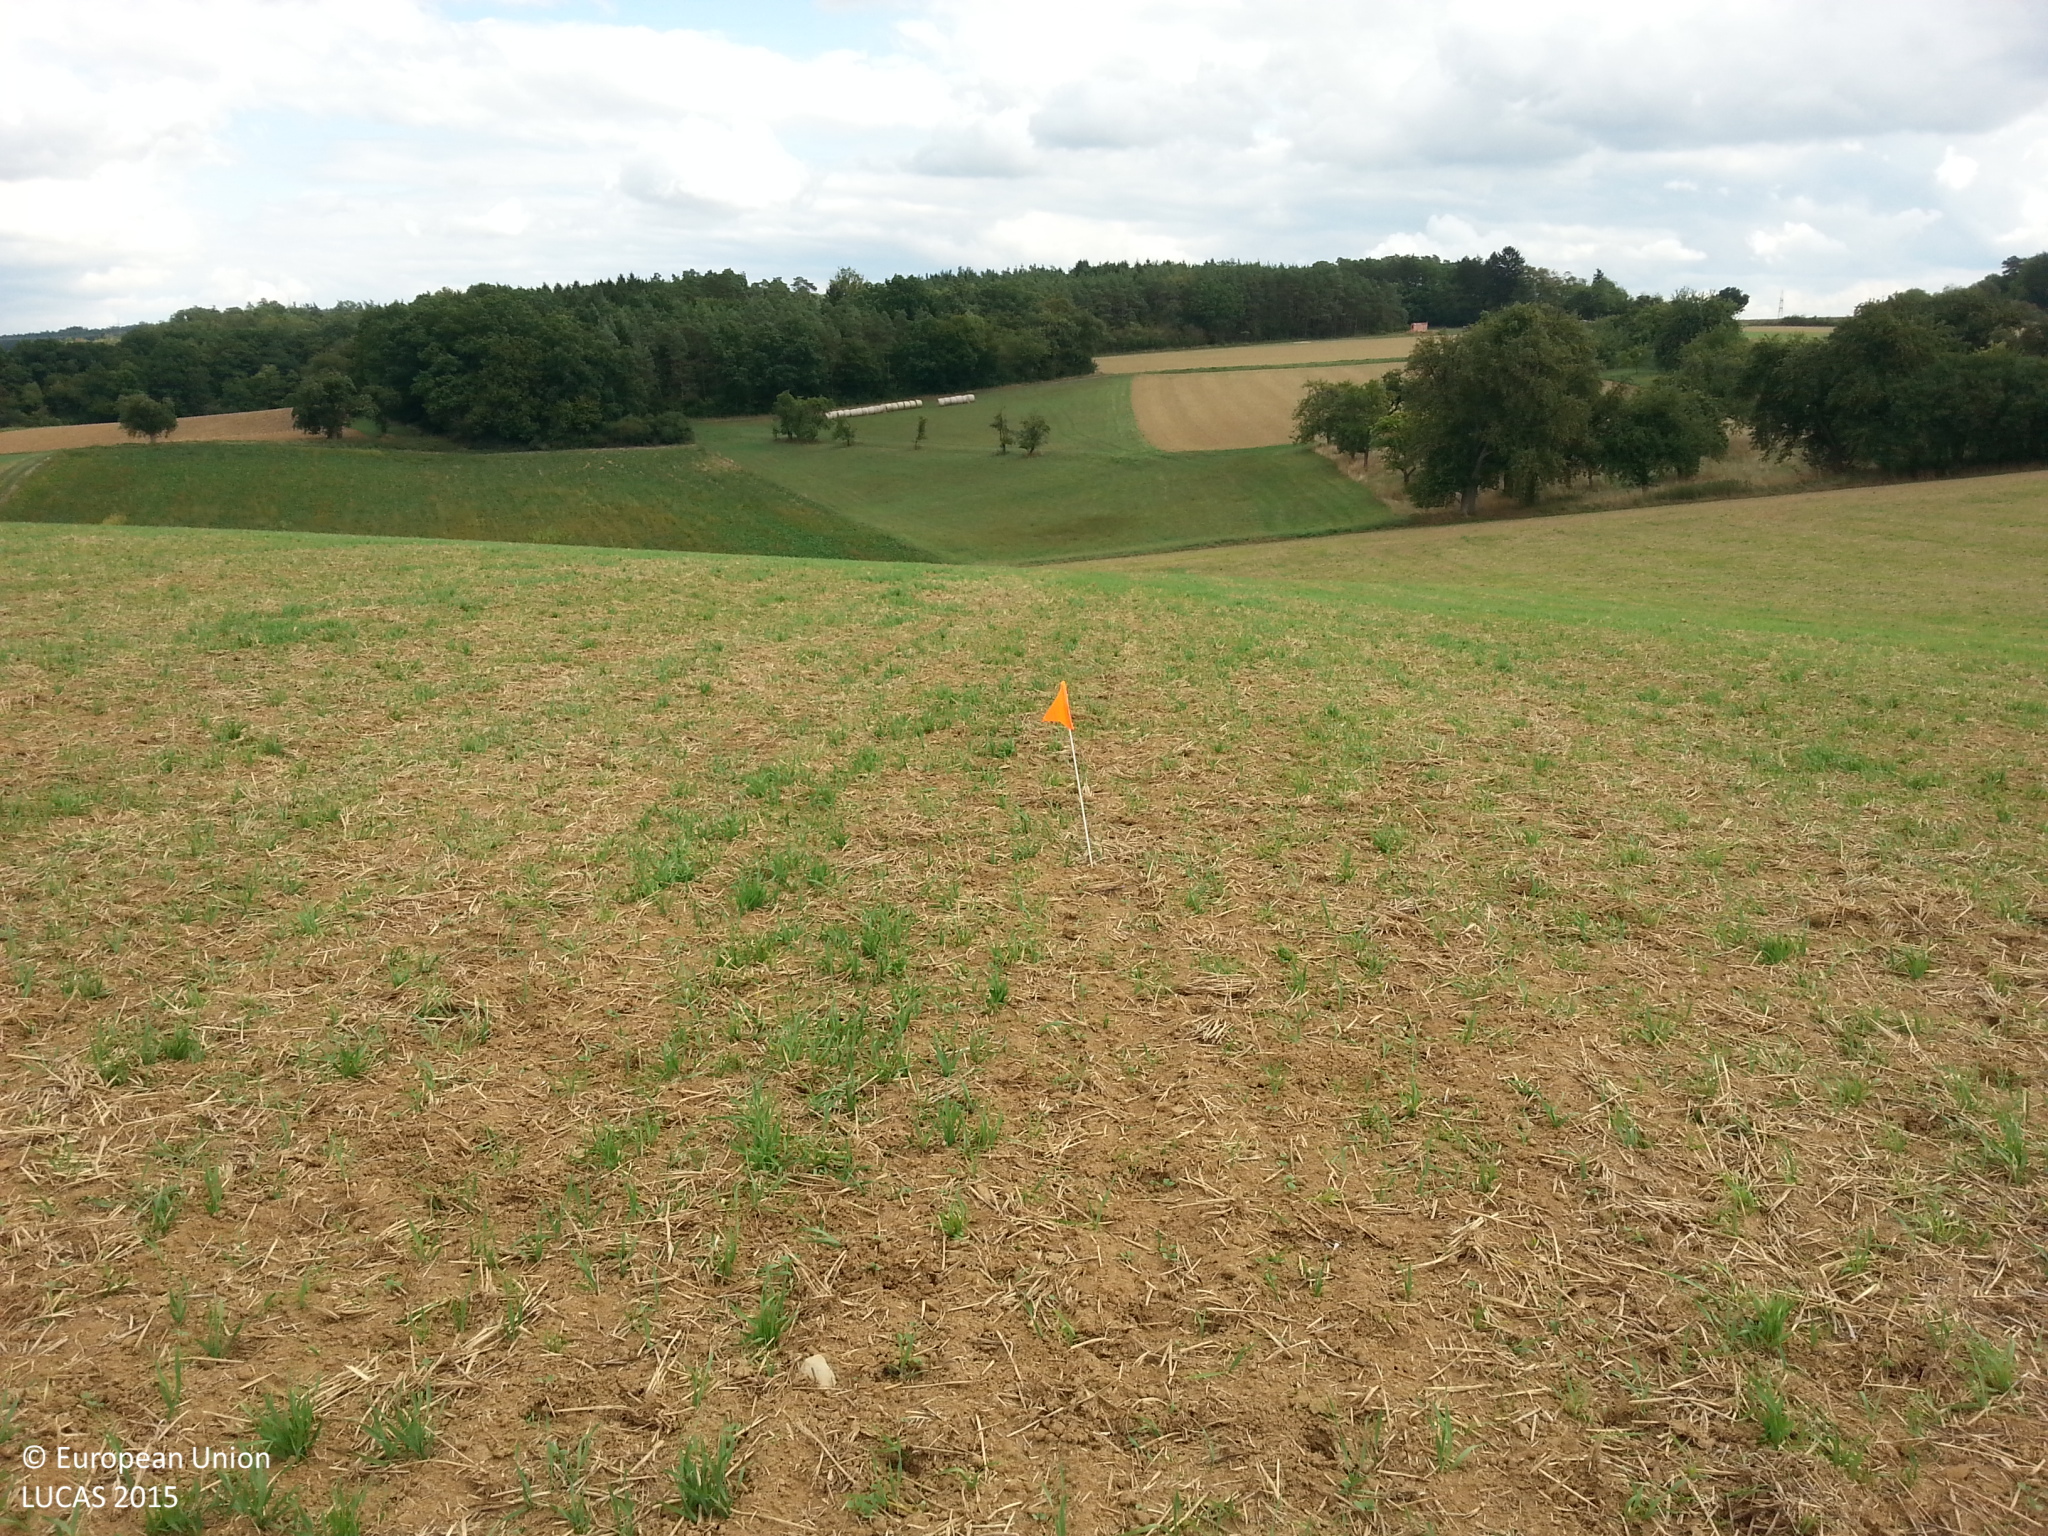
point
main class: Cropland
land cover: Rape and turnip rape
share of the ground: < 10 %
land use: Agriculture (excluding fallow land and kitchen gardens)
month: September
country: DE
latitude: 49.3914
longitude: 9.4078
